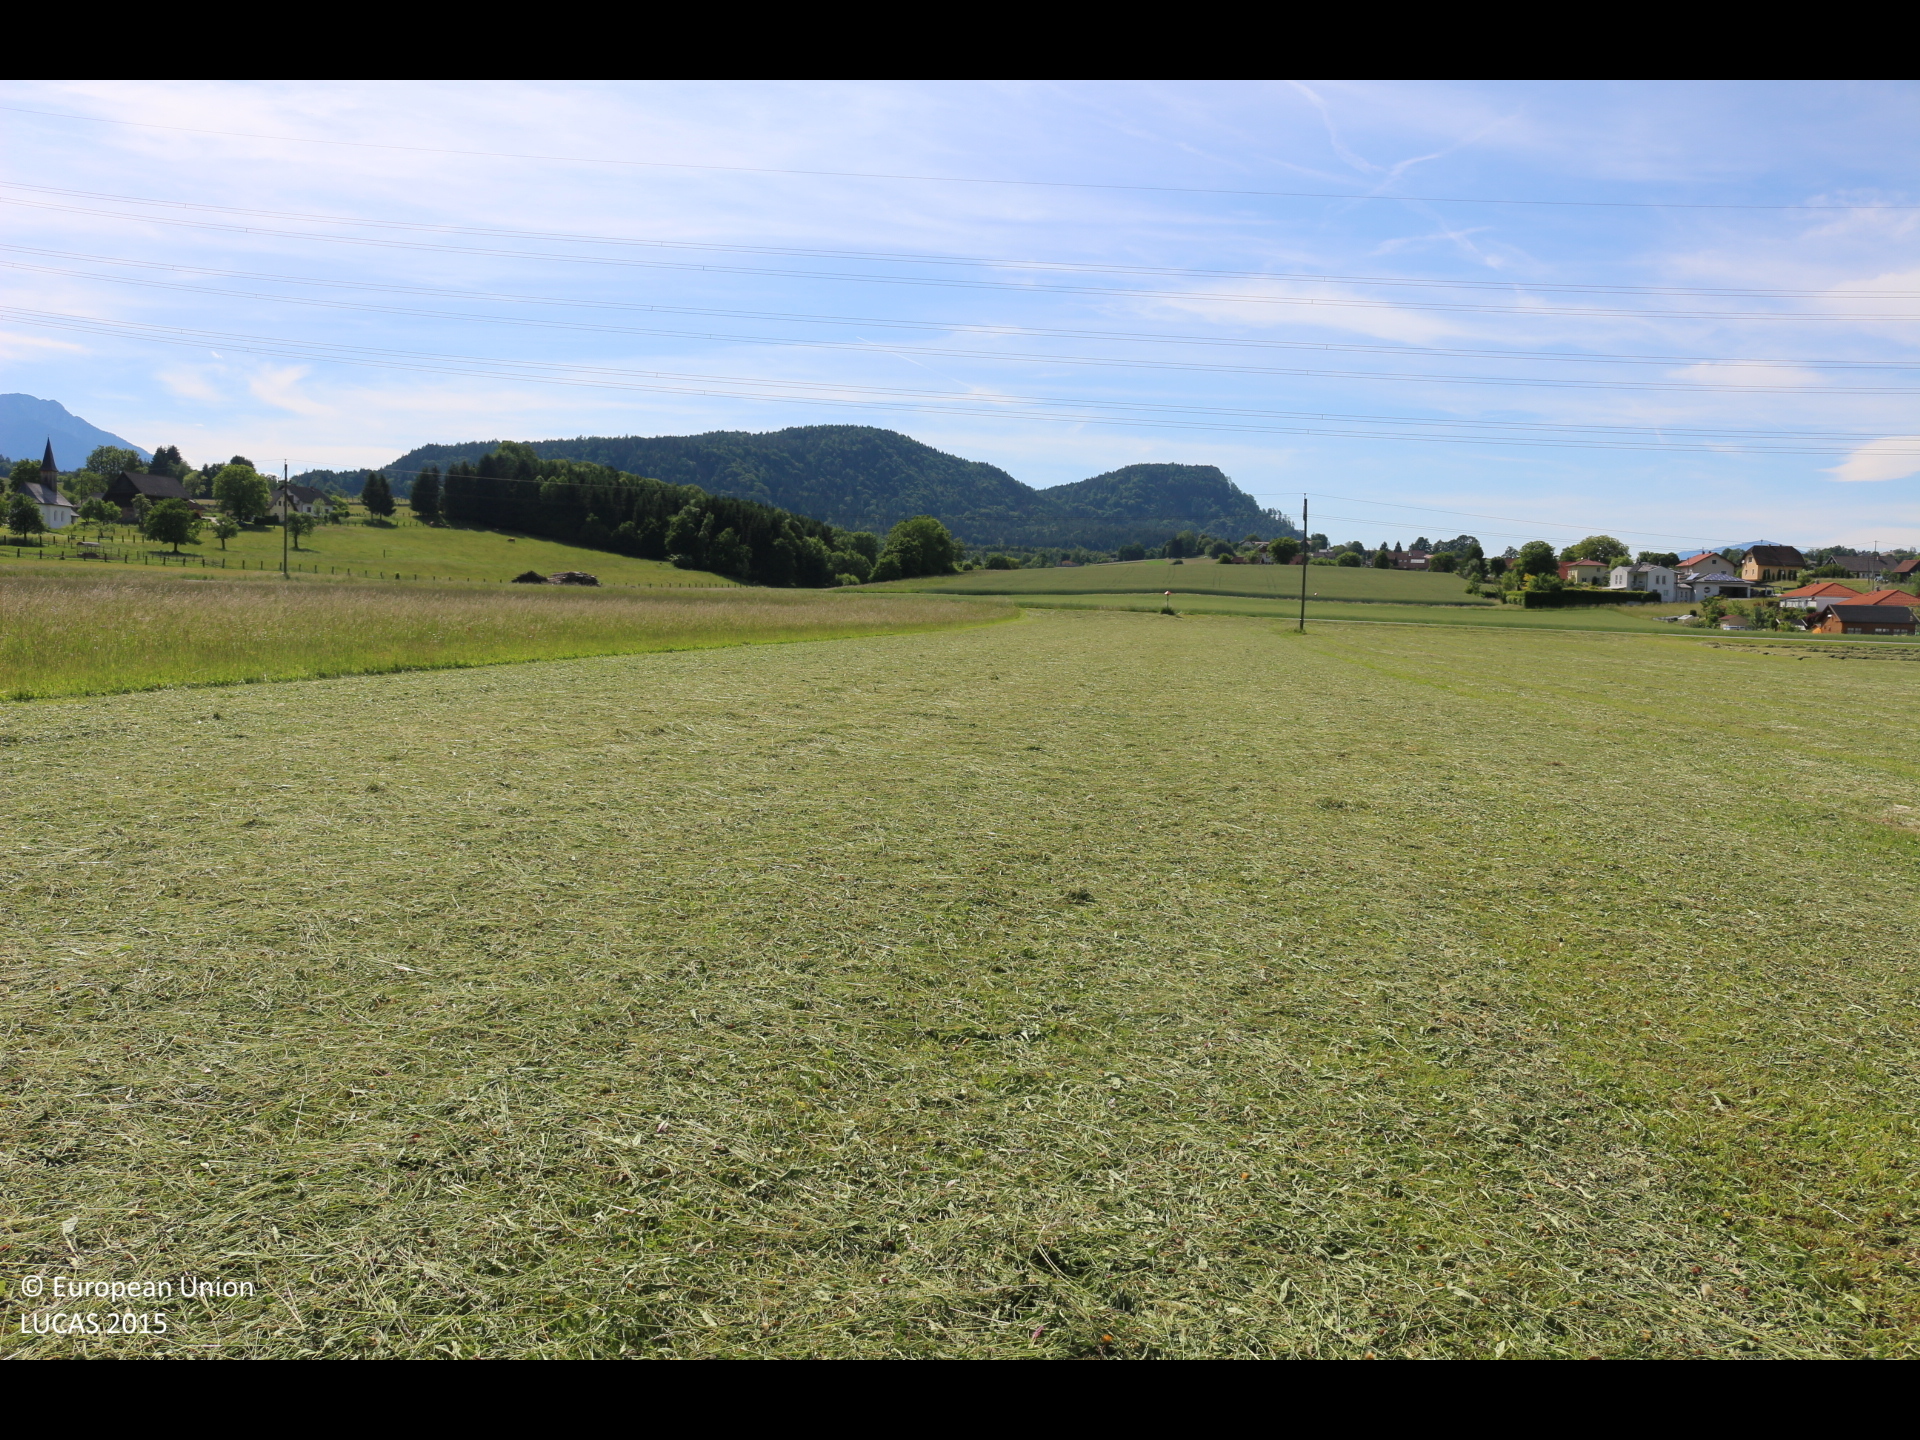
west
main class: Grassland
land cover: Grassland without tree/shrub cover
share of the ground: > 75 %
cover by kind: herbaceous plants 100 %
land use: Agriculture (excluding fallow land and kitchen gardens)
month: May
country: AT
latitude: 46.5639
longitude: 14.0283
